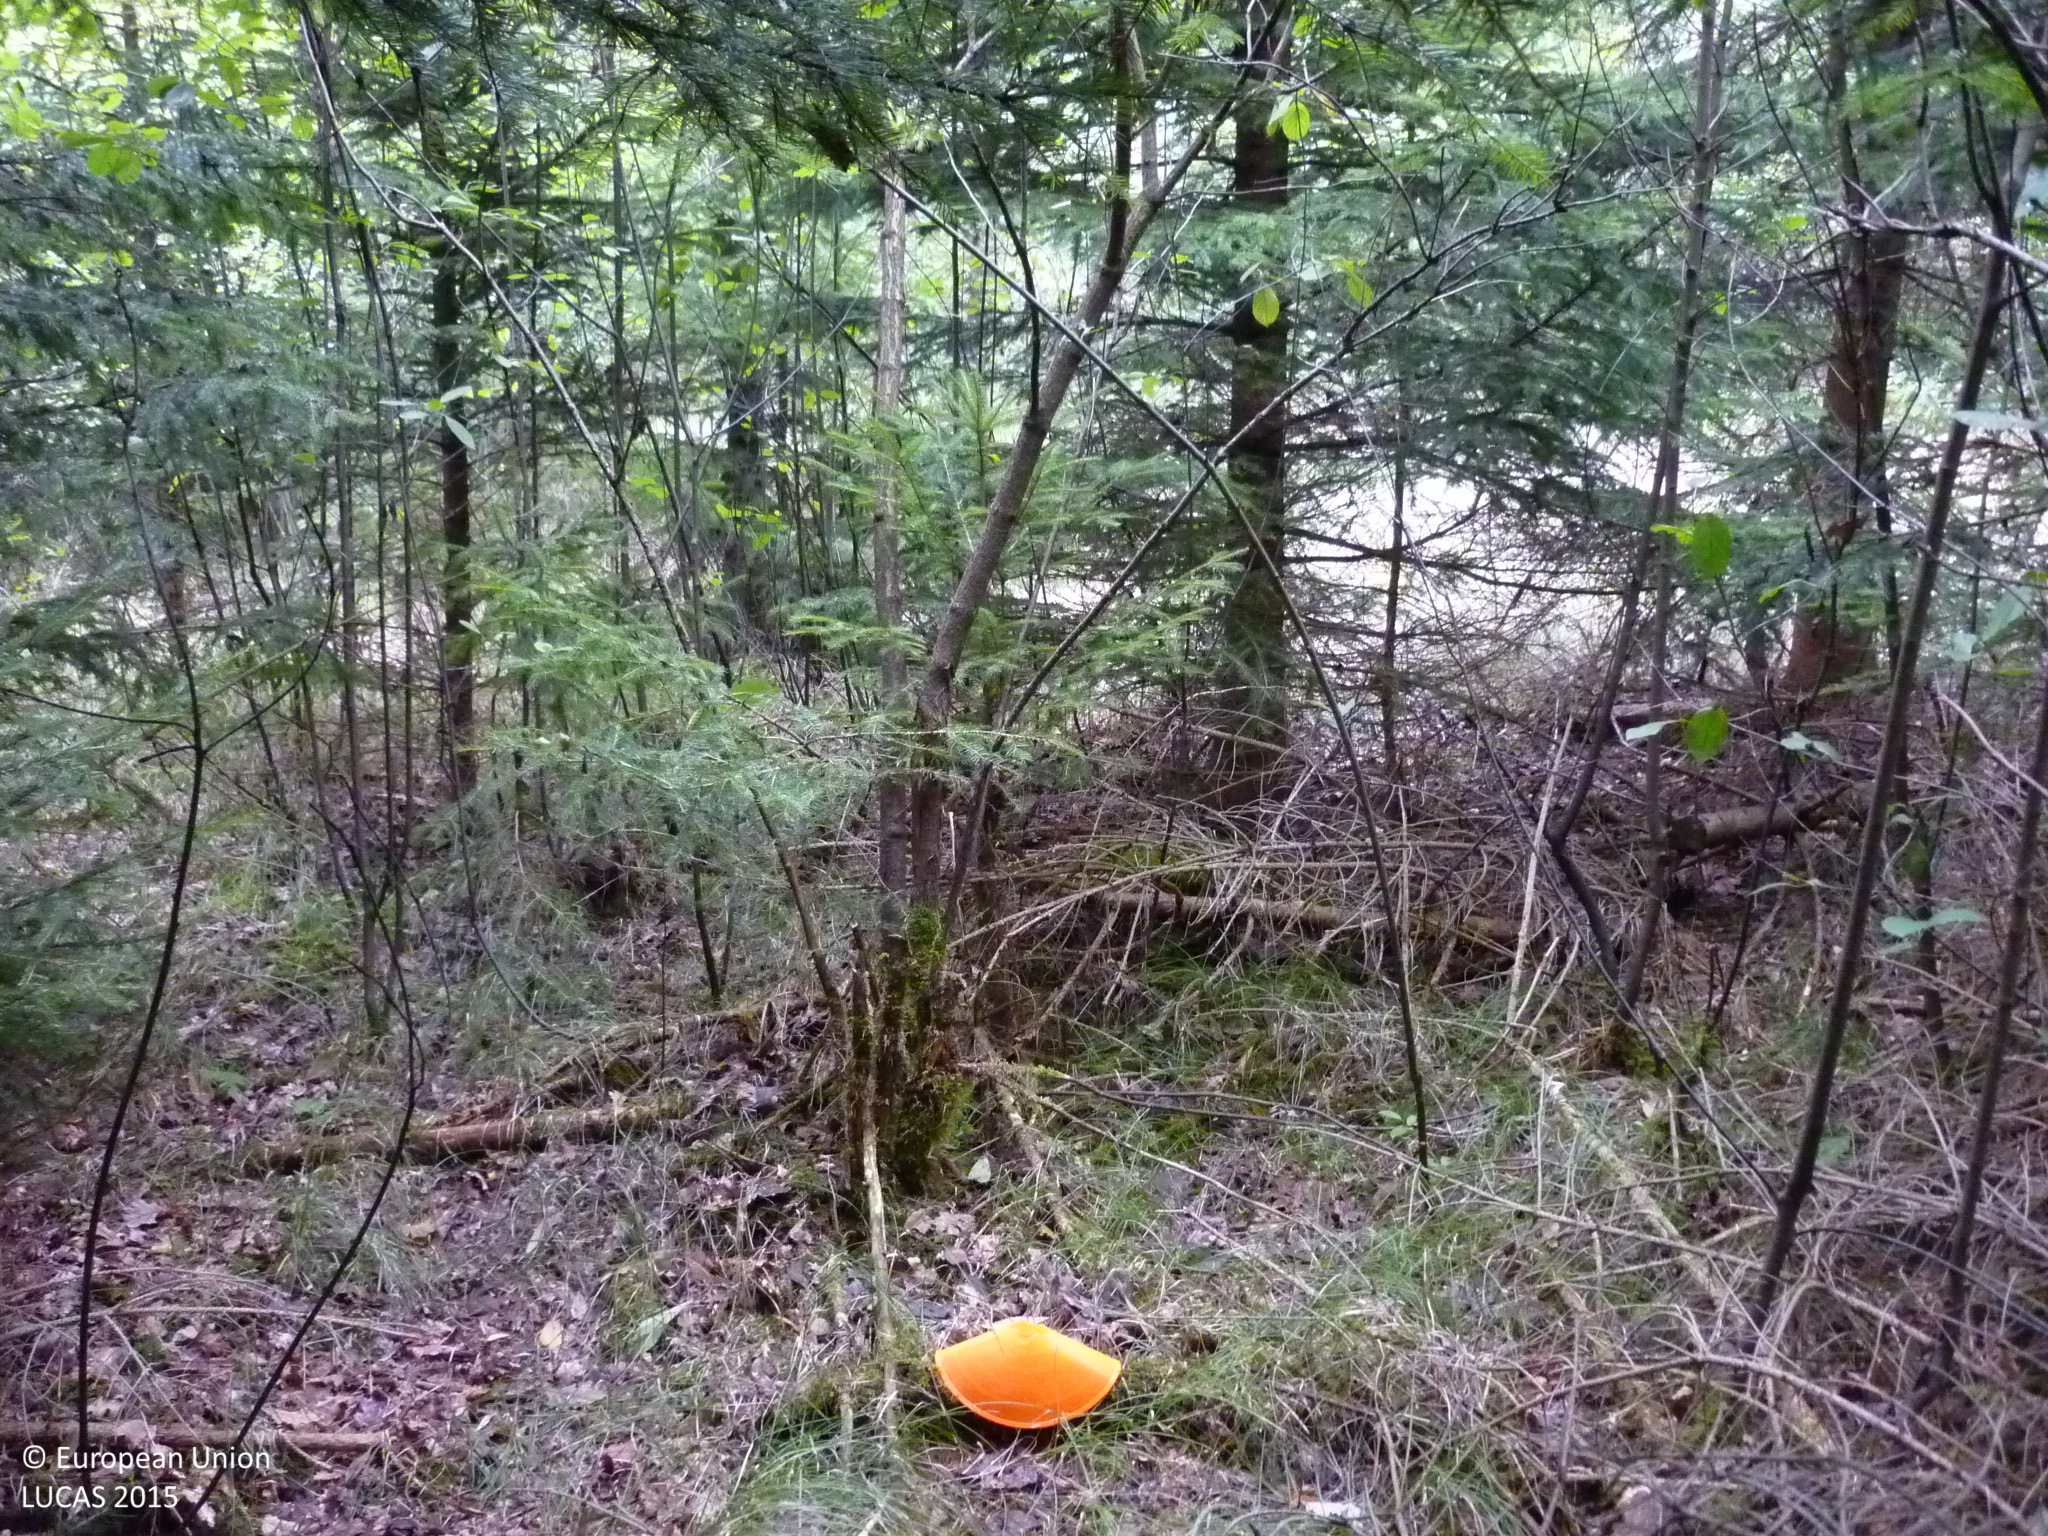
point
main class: Woodland
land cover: Spruce dominated mixed woodland
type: hemiboreal forest and nemoral coniferous forest and mixed broadleaved-coniferous forest
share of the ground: > 75 %
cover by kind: coniferous forest trees 70 %, broadleaved forest trees 30 %
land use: Forestry
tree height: > 5 m
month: September
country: AT
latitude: 48.8120
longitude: 15.0269
